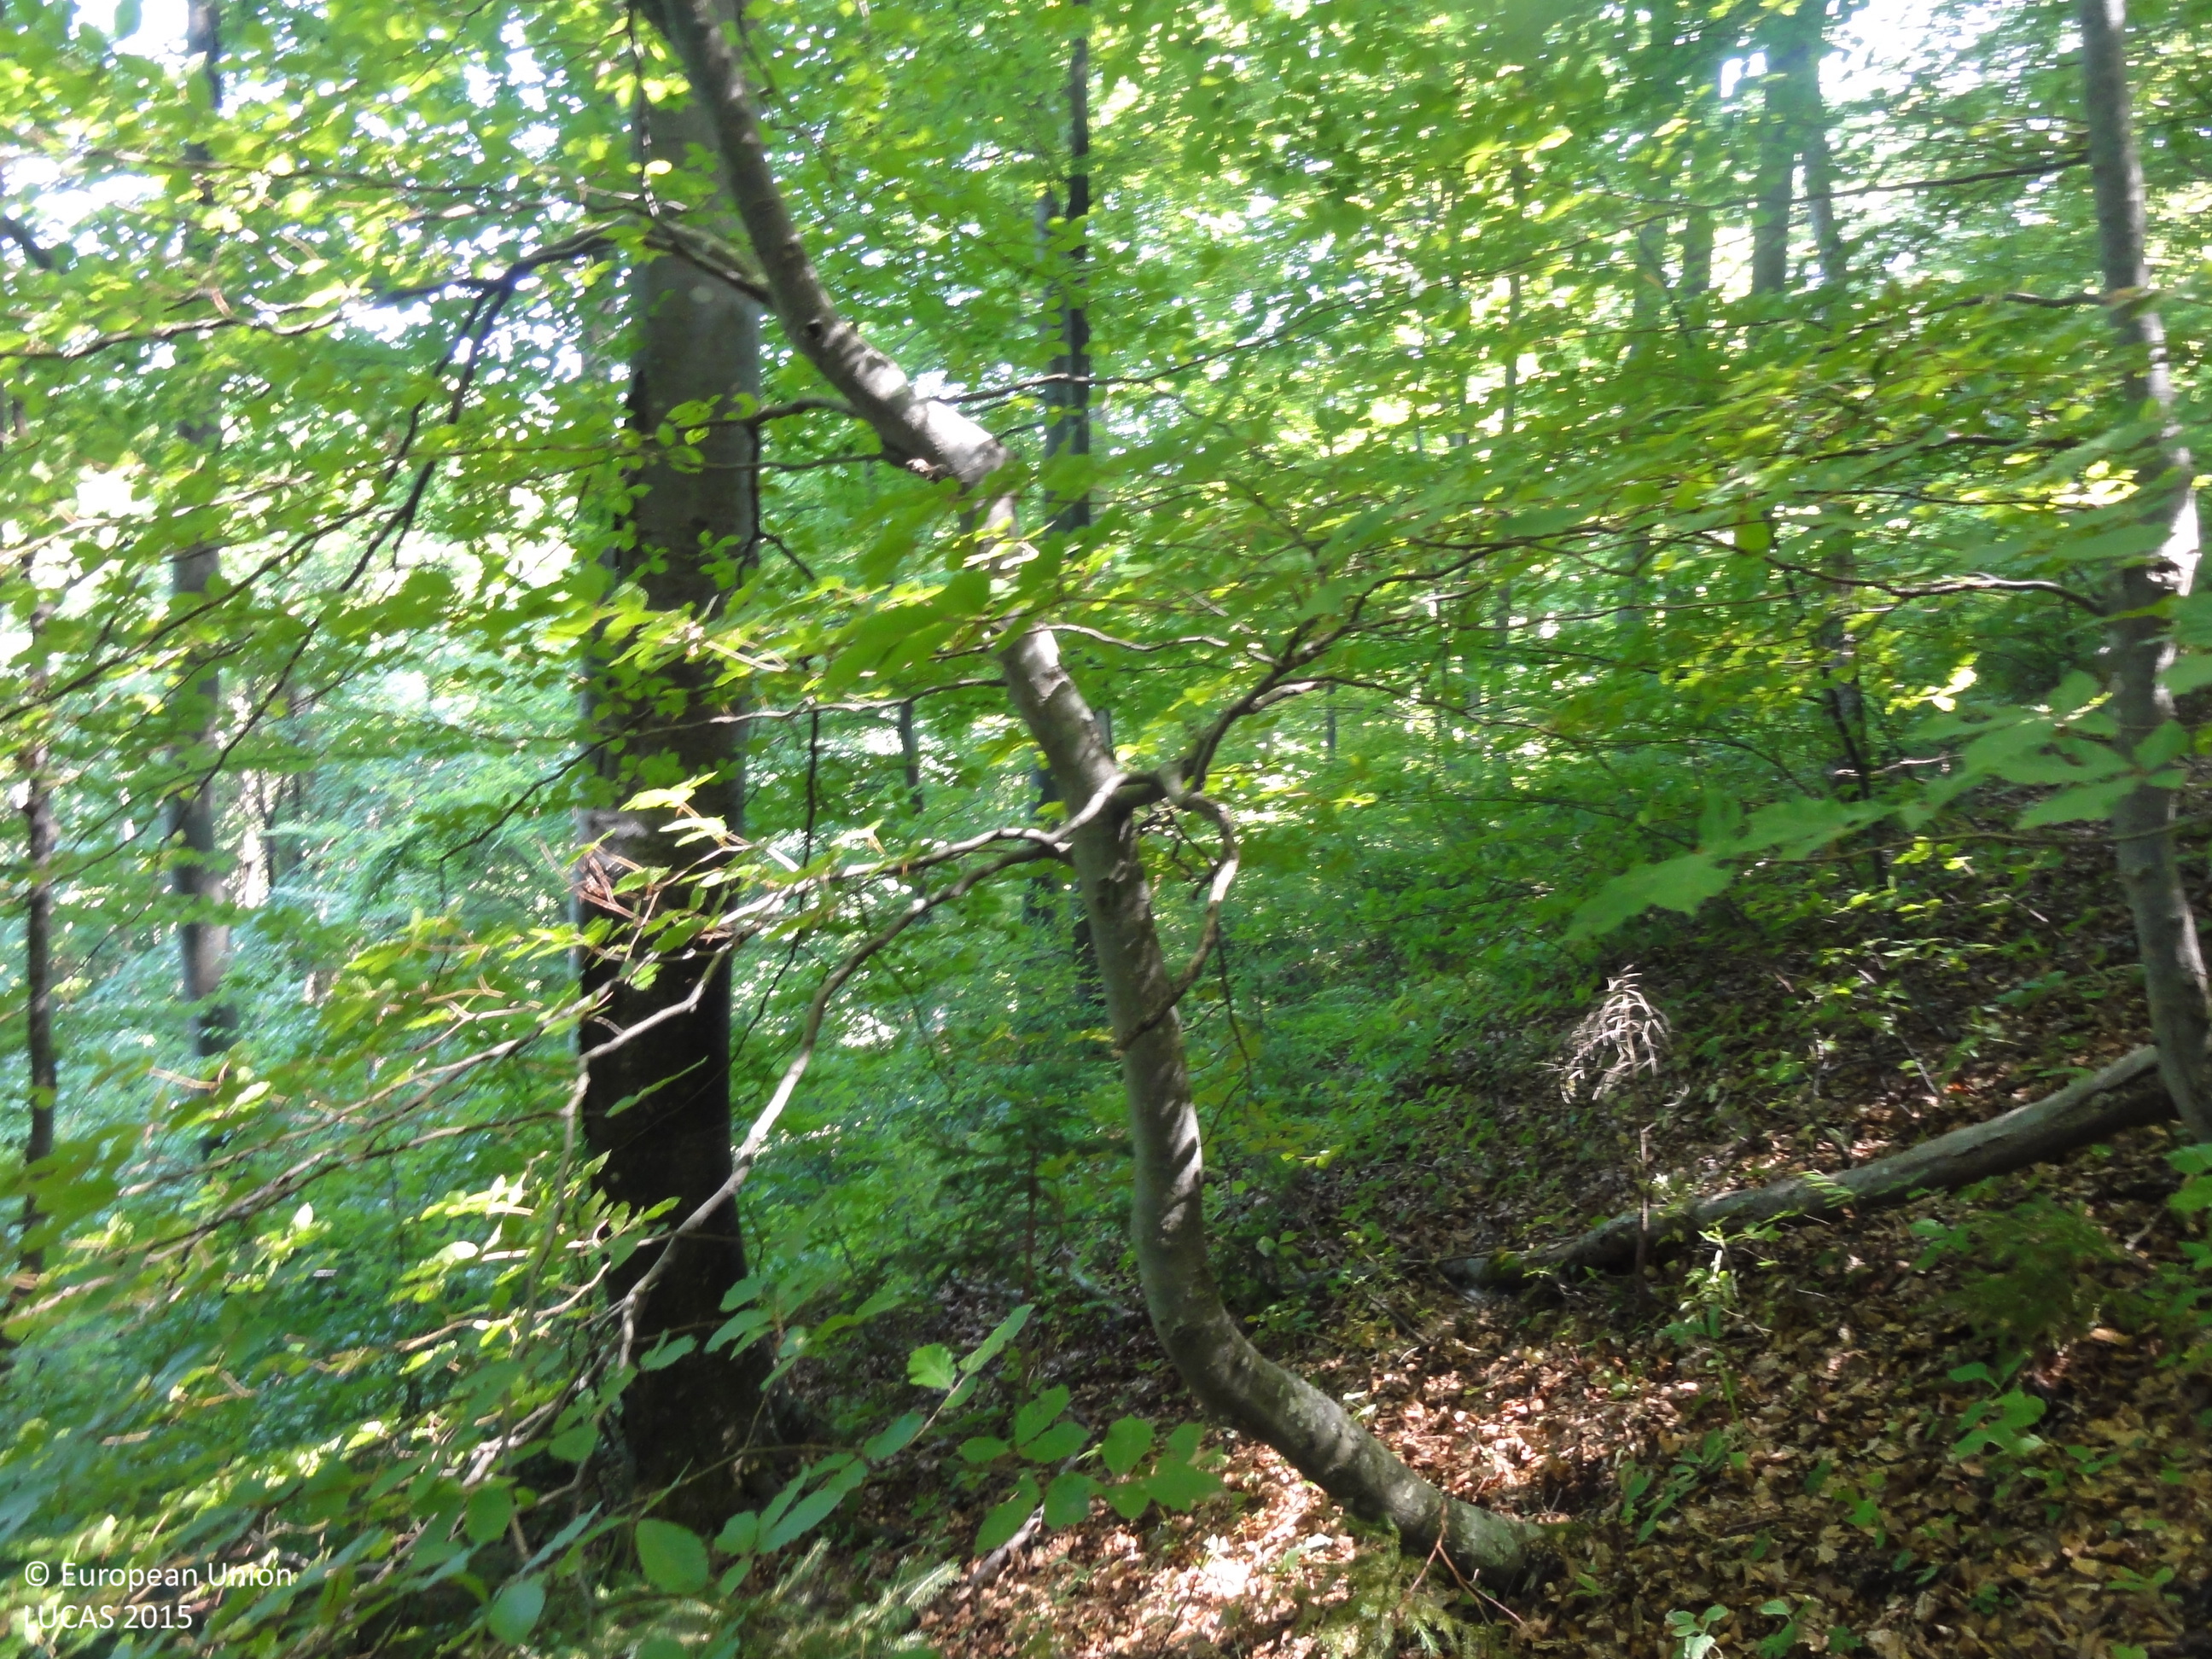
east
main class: Woodland
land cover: Broadleaved woodland
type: mountainous beech forest
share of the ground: > 75 %
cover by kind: broadleaved forest trees 100 %
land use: Forestry
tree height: > 5 m
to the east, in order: Broadleaved woodland; Tracks; Broadleaved woodland; Rivers and streams; Broadleaved woodland; Rivers and streams; Spruce dominated mixed woodland
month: August
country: SI
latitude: 46.0515
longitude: 15.0504
